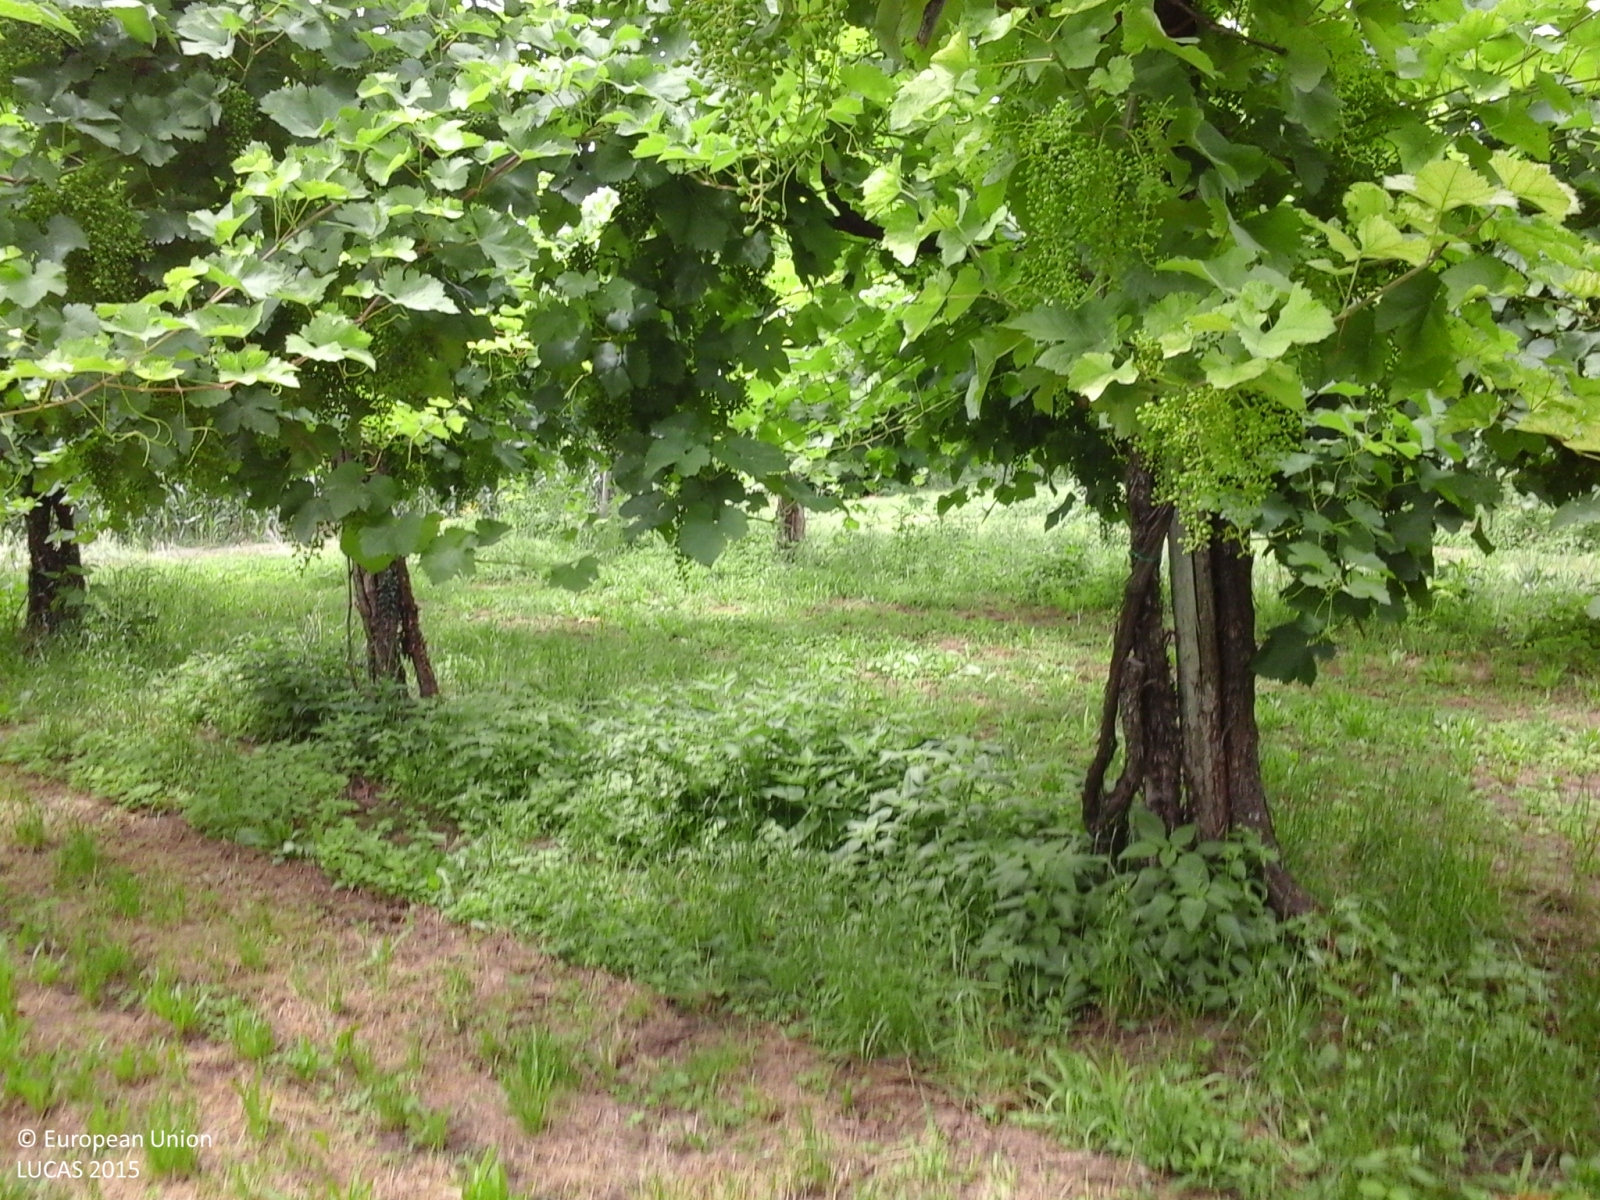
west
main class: Cropland
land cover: Vineyards
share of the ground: > 75 %
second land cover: Grassland without tree/shrub cover
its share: > 75 %
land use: Agriculture (excluding fallow land and kitchen gardens)
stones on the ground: < 10 %
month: June
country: IT
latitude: 45.7290
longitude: 12.4252
